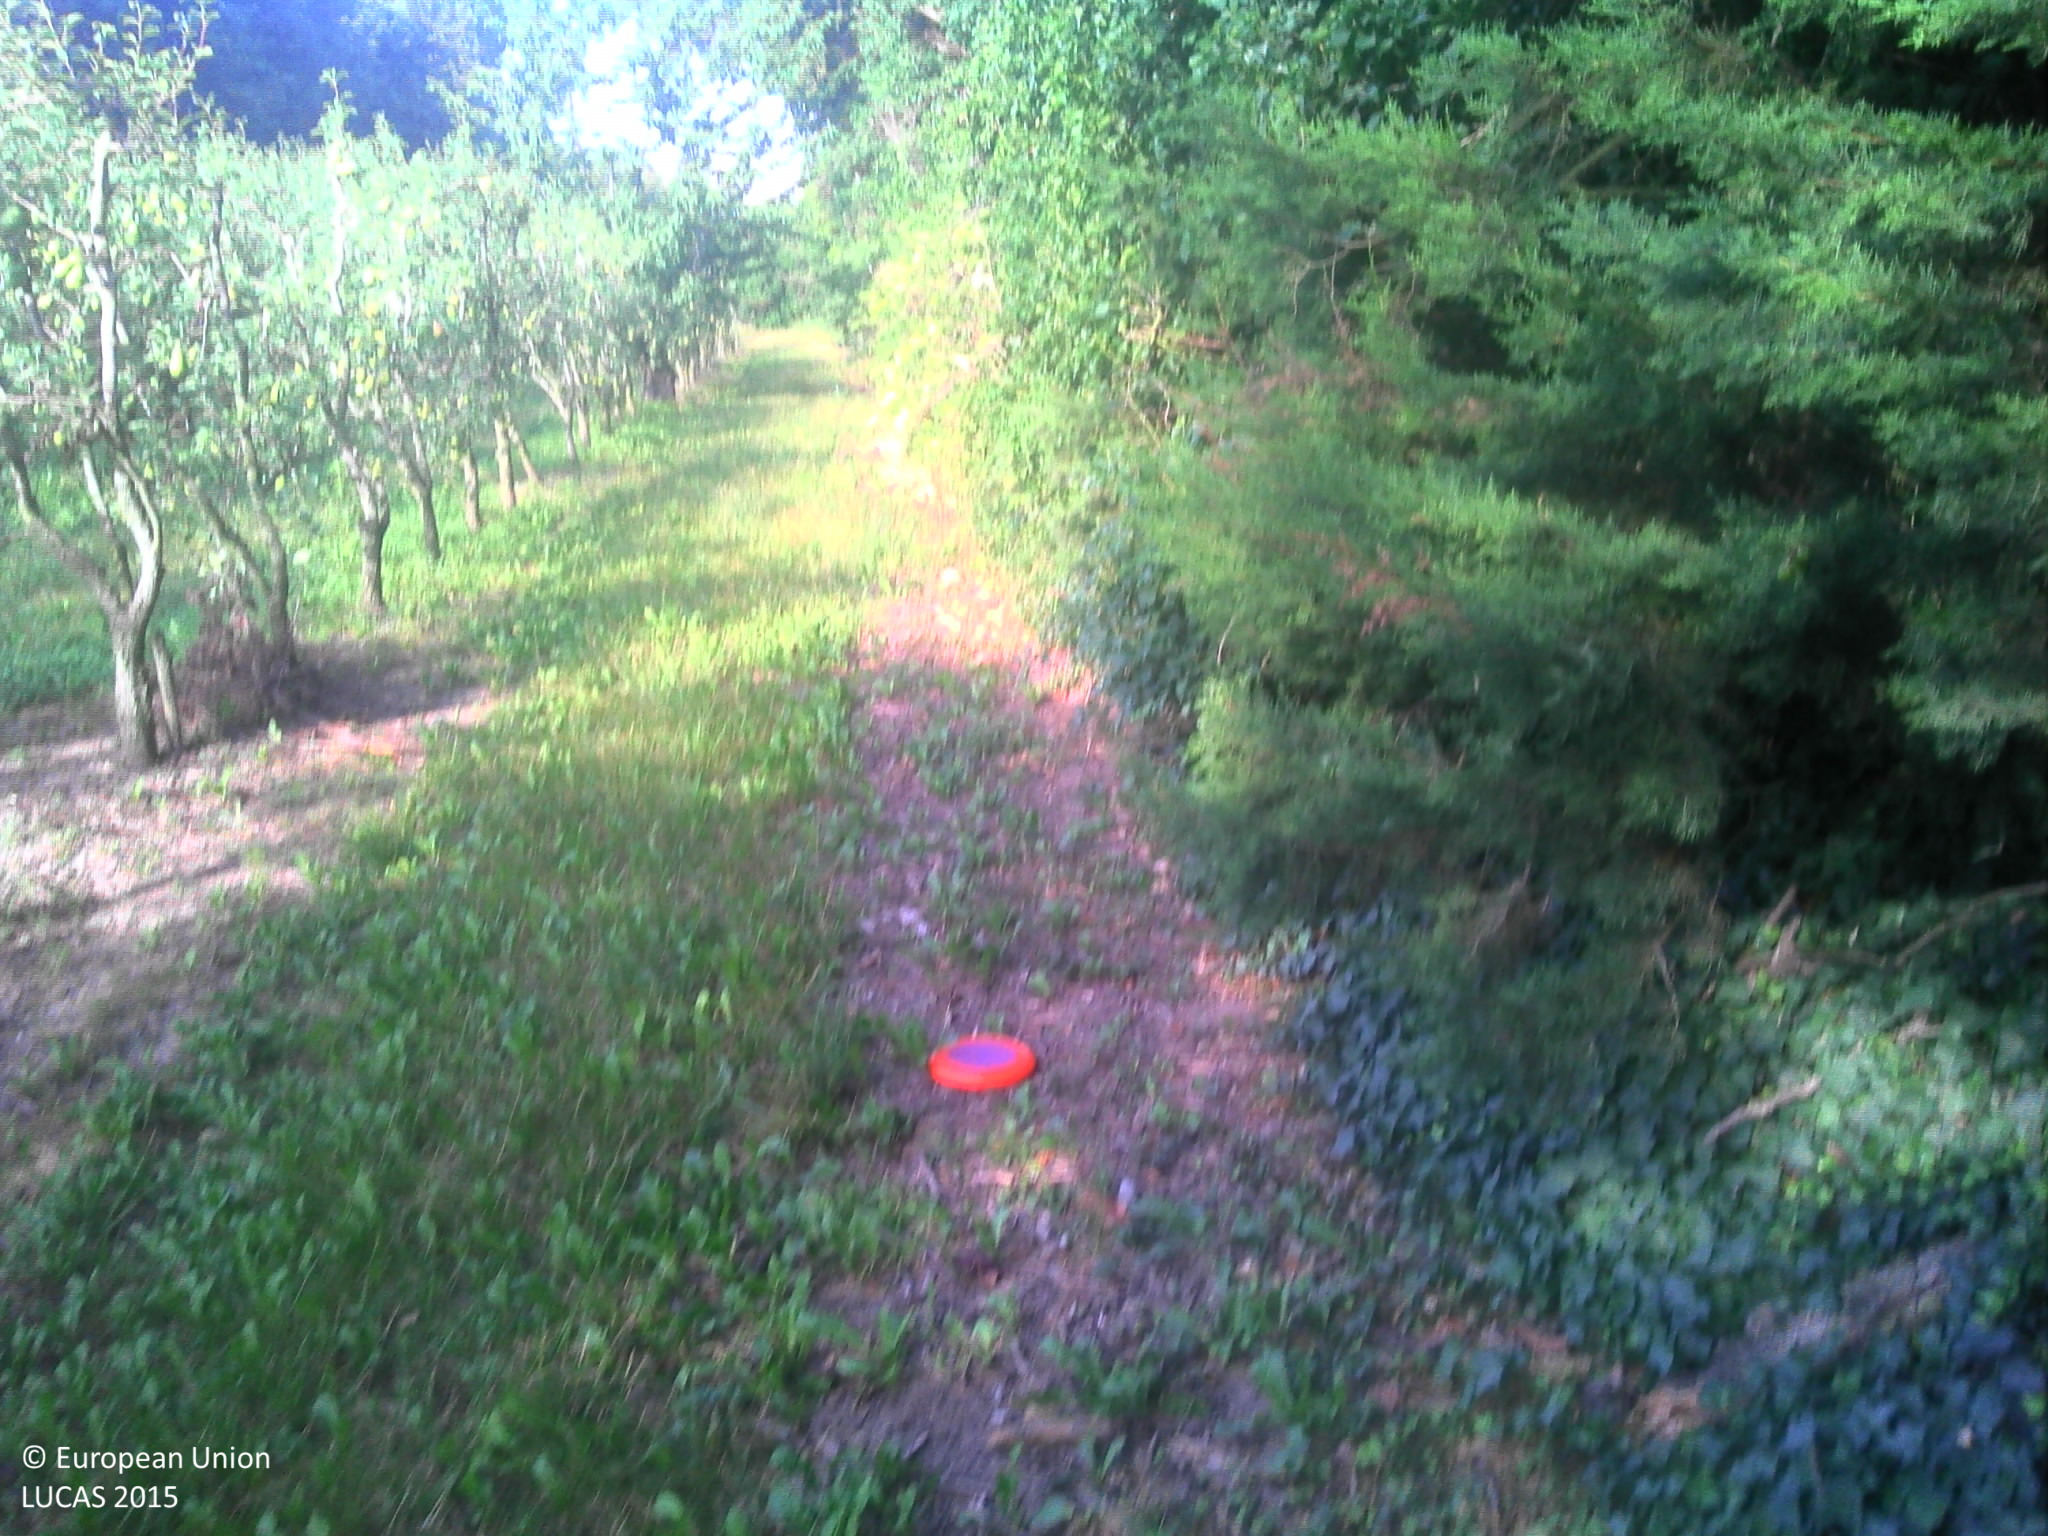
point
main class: Cropland
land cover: Pear fruit
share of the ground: > 75 %
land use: Agriculture (excluding fallow land and kitchen gardens)
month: July
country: FR
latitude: 43.7640
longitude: 5.0777
